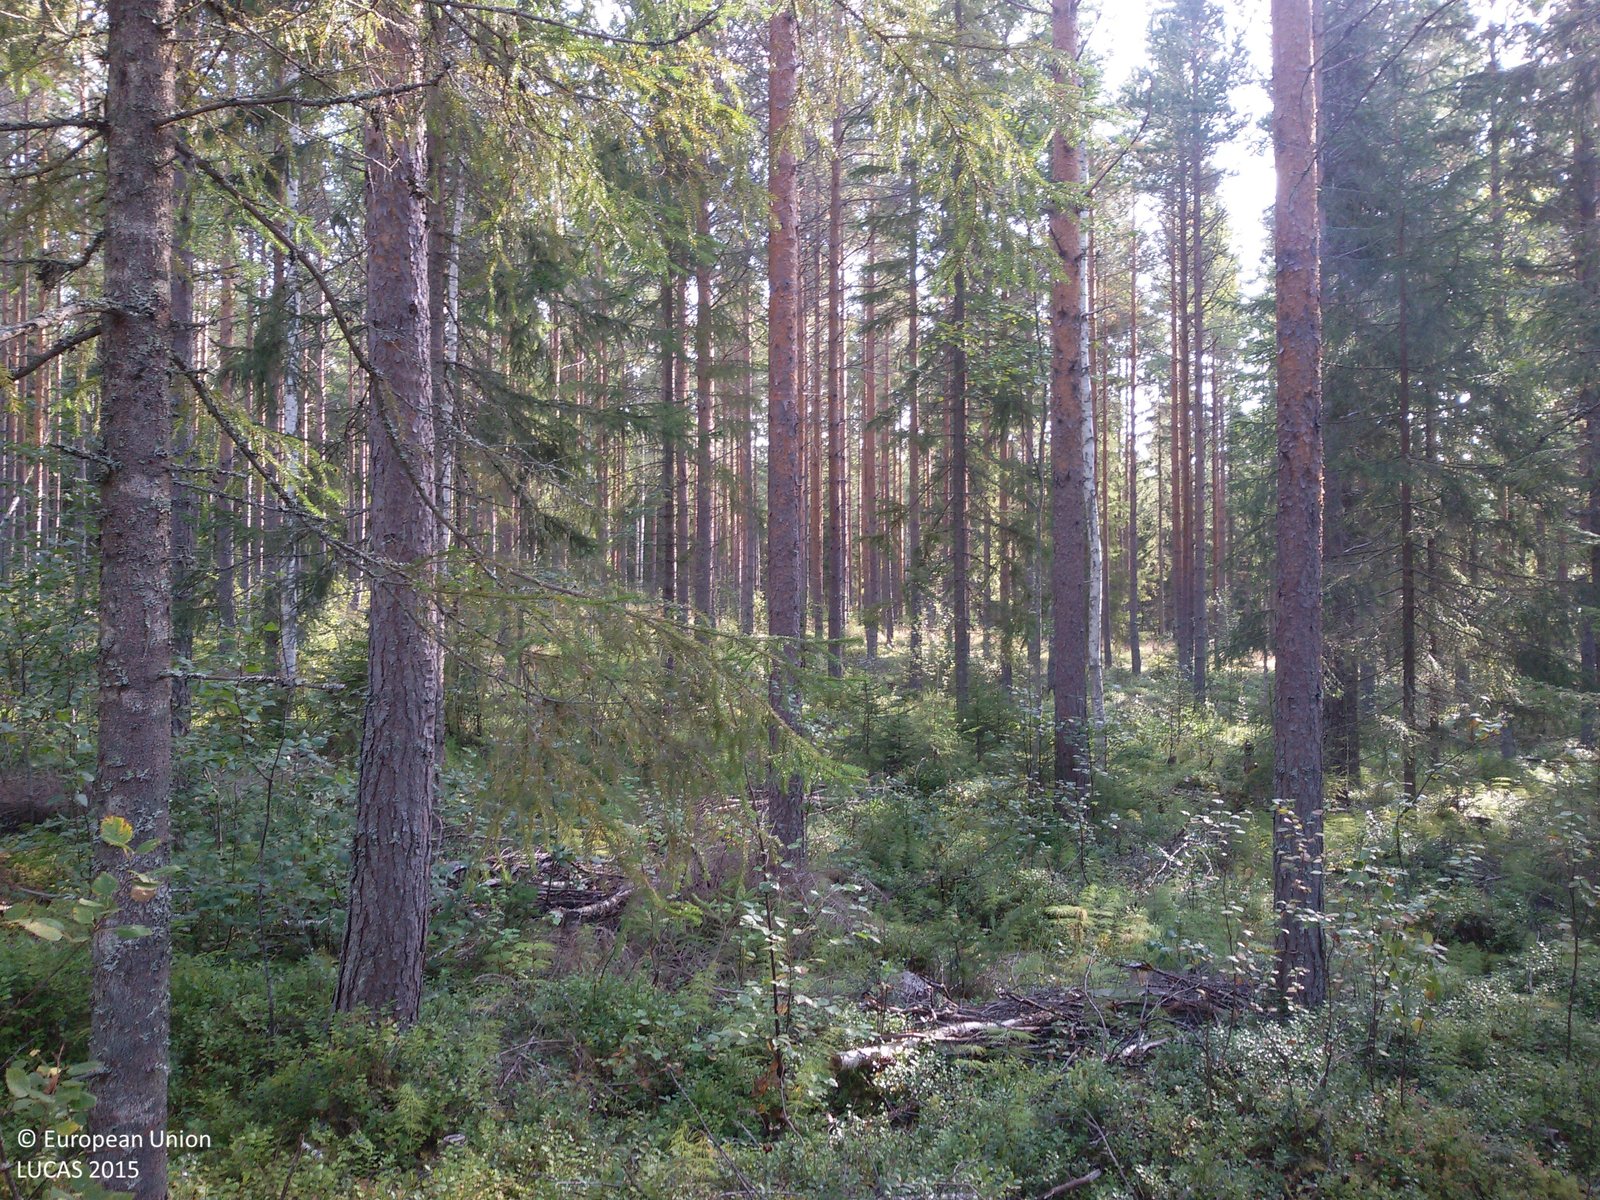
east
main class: Woodland
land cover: Pine dominated coniferous woodland
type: boreal forest
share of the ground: 50 - 75 %
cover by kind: coniferous forest trees 70 %, herbaceous plants 25 %, lichens and mosses 5 %
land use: Forestry
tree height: > 5 m
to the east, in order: Pine dominated coniferous woodland; Pine dominated mixed woodland; Spruce dominated coniferous woodland
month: September
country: SE
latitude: 60.9573
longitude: 15.0275
